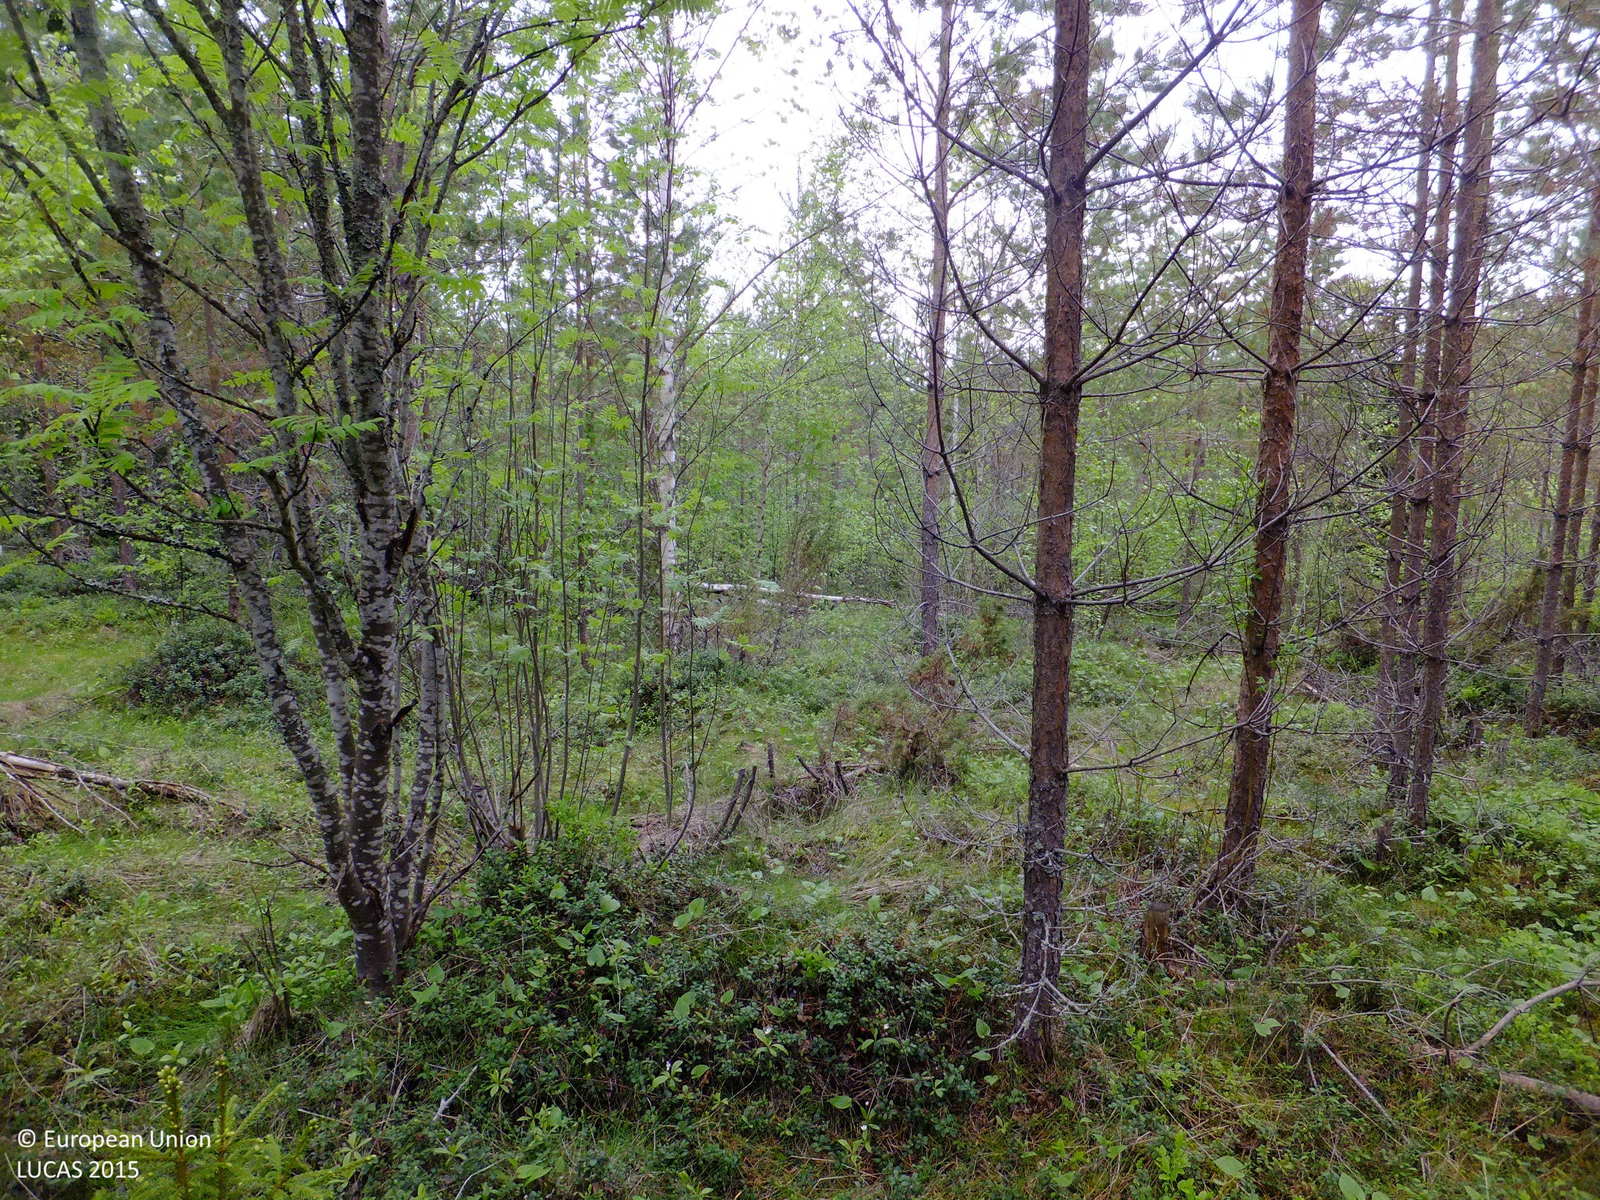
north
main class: Woodland
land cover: Pine dominated mixed woodland
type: boreal forest
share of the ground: > 75 %
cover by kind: coniferous forest trees 55 %, broadleaved forest trees 20 %, herbaceous plants 15 %, shrubs 10 %
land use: Forestry
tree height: < 5 m
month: June
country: FI
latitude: 63.4621
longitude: 23.1569
